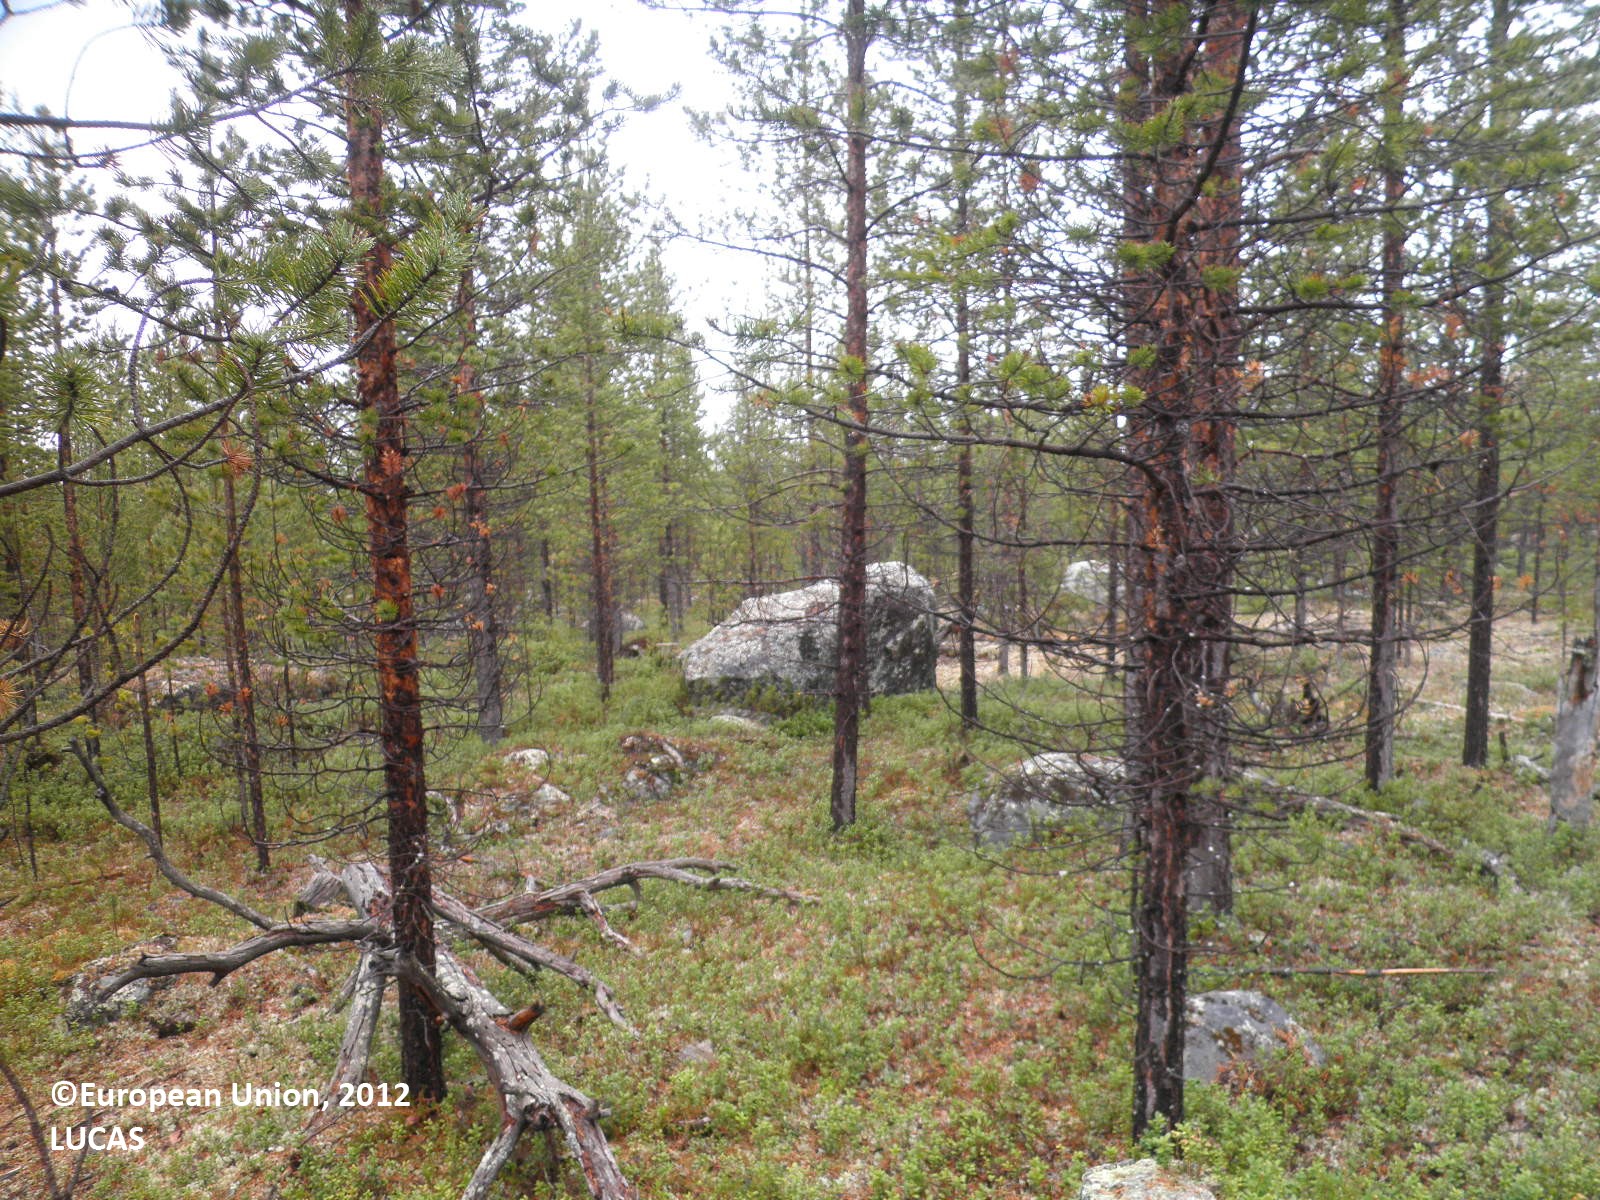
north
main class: Woodland
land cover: Pine dominated coniferous woodland
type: boreal forest
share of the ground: 50 - 75 %
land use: Forestry
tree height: > 5 m
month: June
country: FI
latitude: 68.8978
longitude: 26.7534
